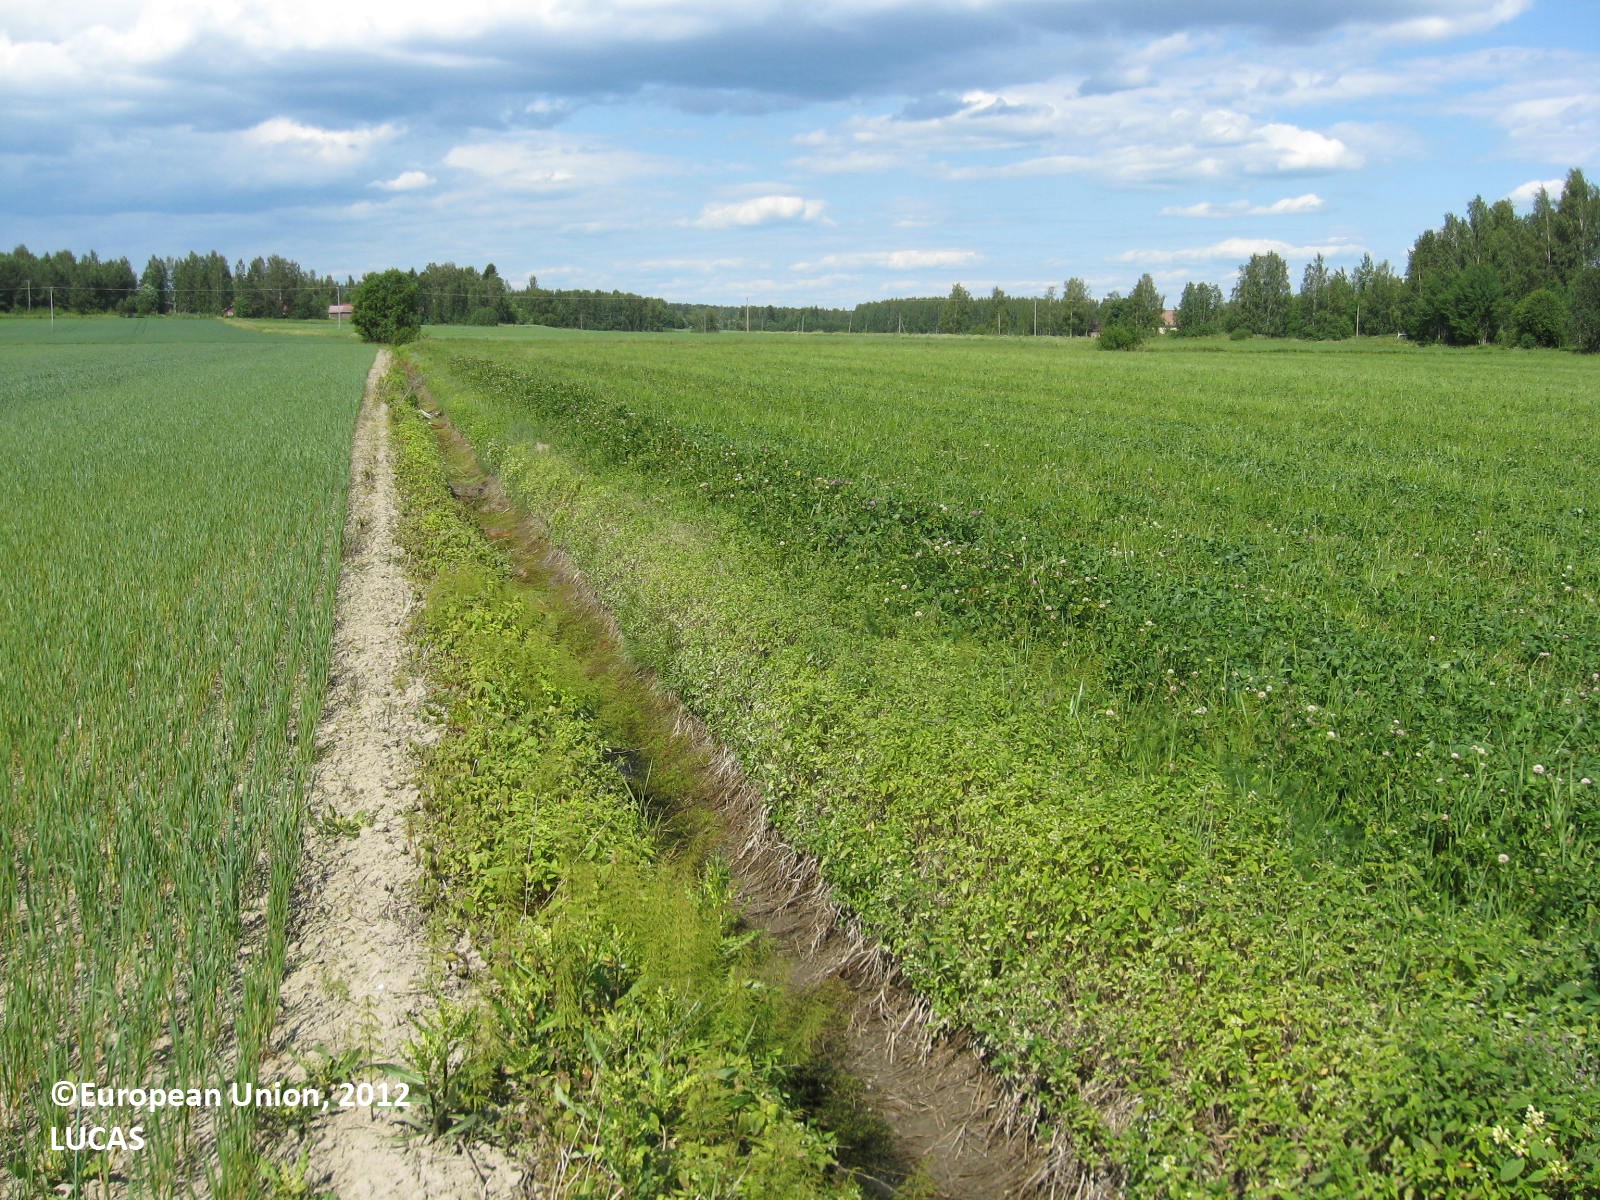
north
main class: Cropland
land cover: Common wheat
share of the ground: > 75 %
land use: Agriculture (excluding fallow land and kitchen gardens)
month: July
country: FI
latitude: 62.5804
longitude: 22.5326
